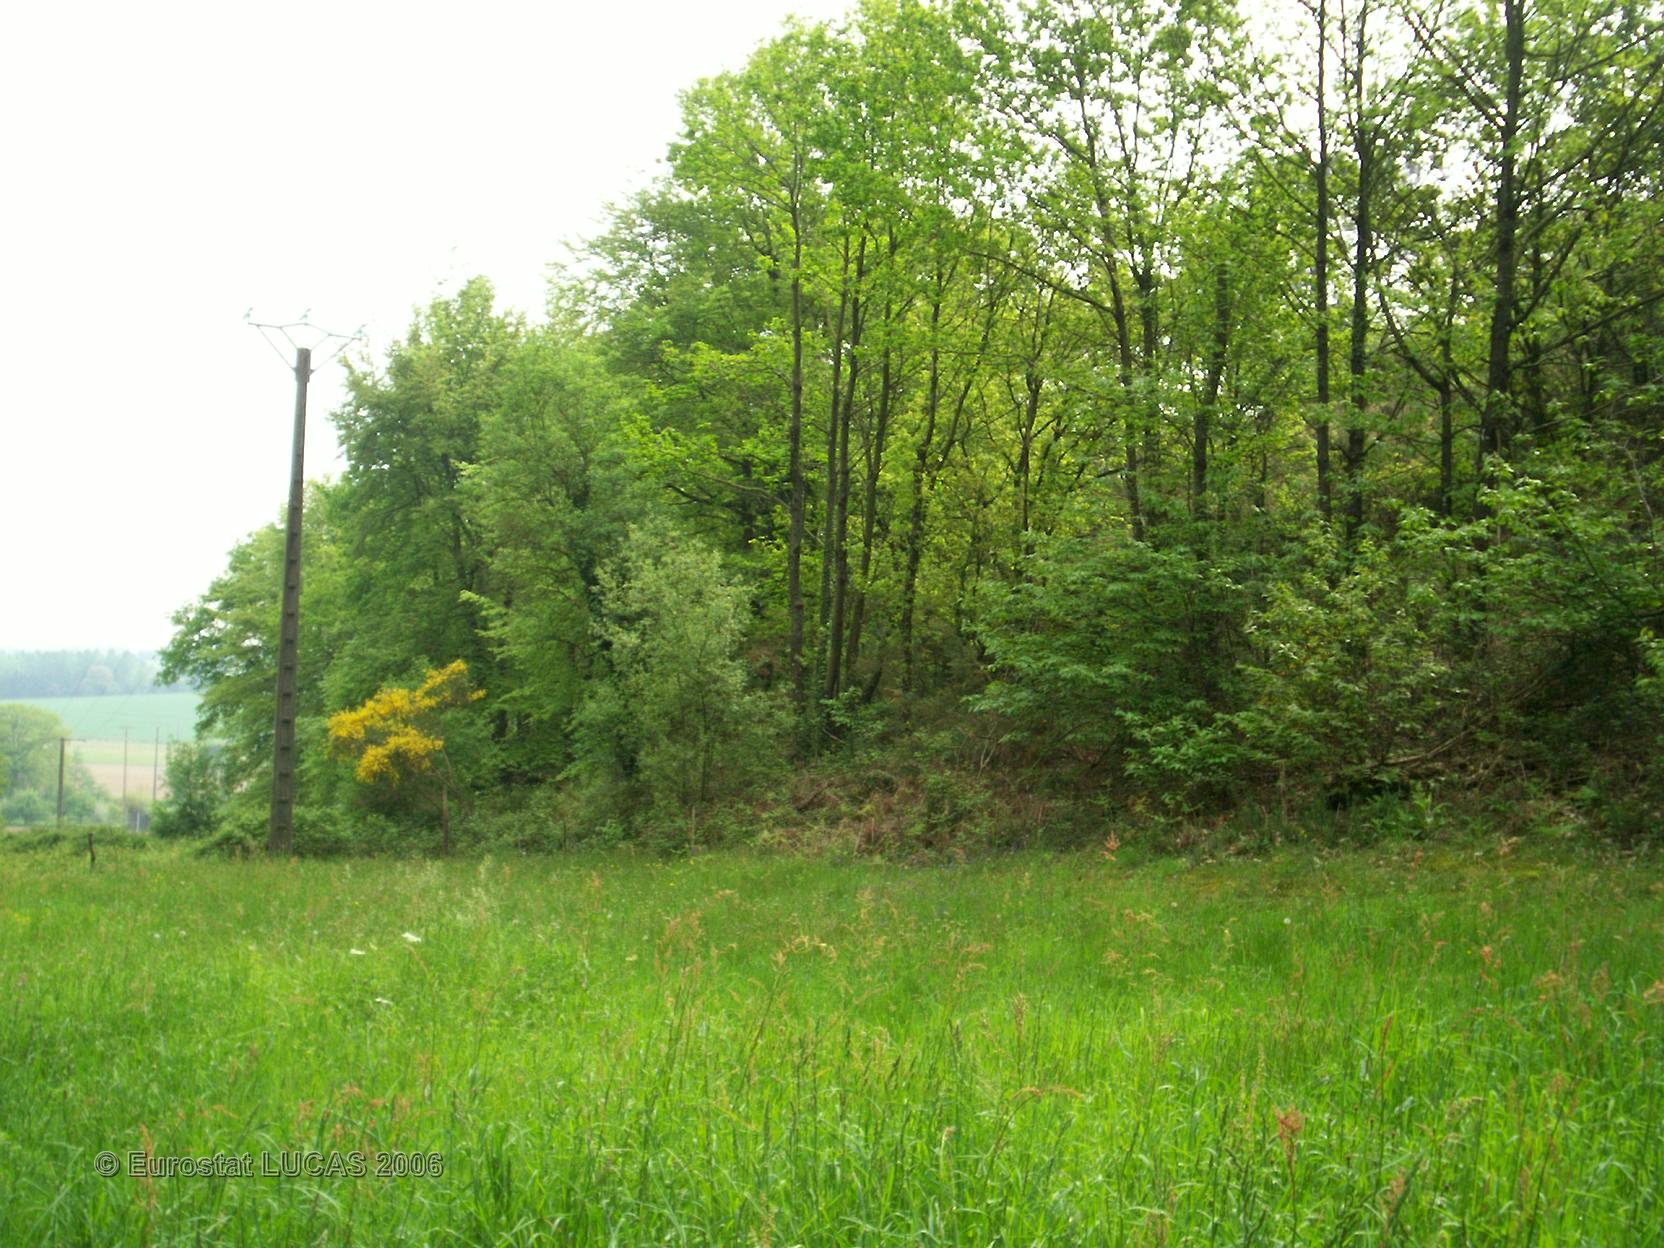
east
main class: Grassland
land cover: Grassland without tree/shrub cover
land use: Unused
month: May
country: FR
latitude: 47.7840
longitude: -2.3218
